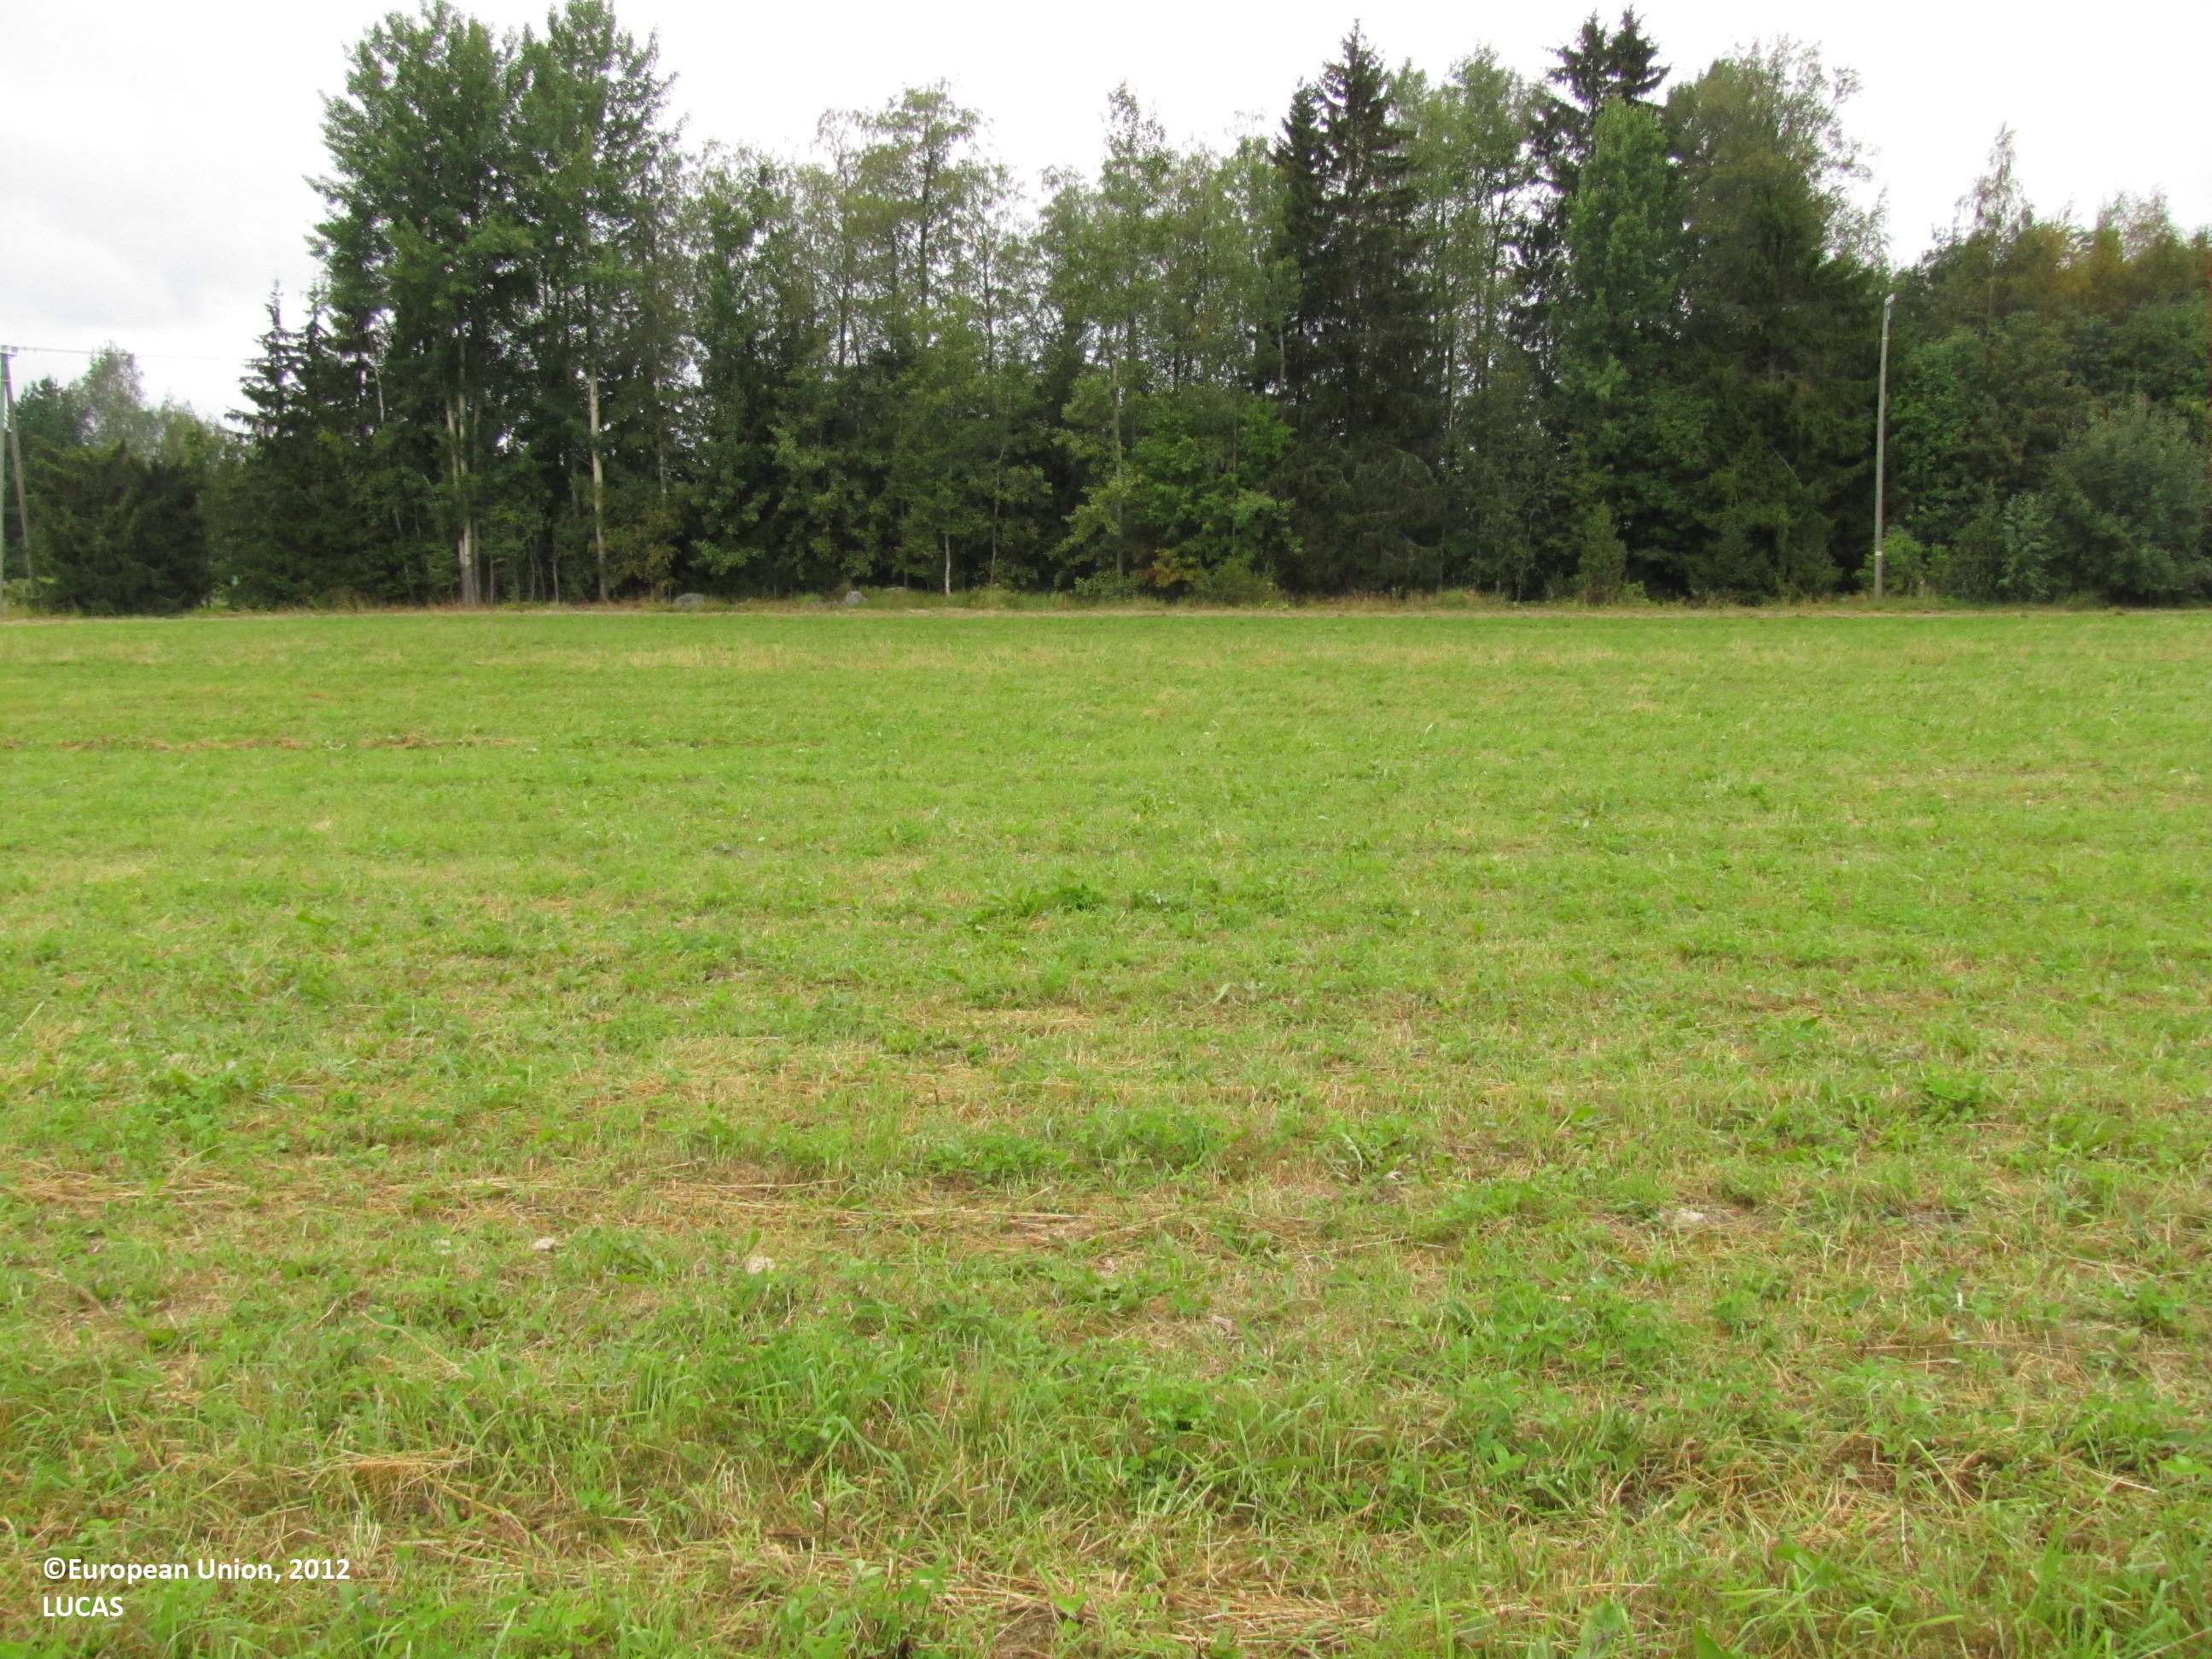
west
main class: Cropland
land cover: Temporary grasslands
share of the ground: > 75 %
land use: Agriculture (excluding fallow land and kitchen gardens)
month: August
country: FI
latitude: 61.5469
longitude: 23.6473
